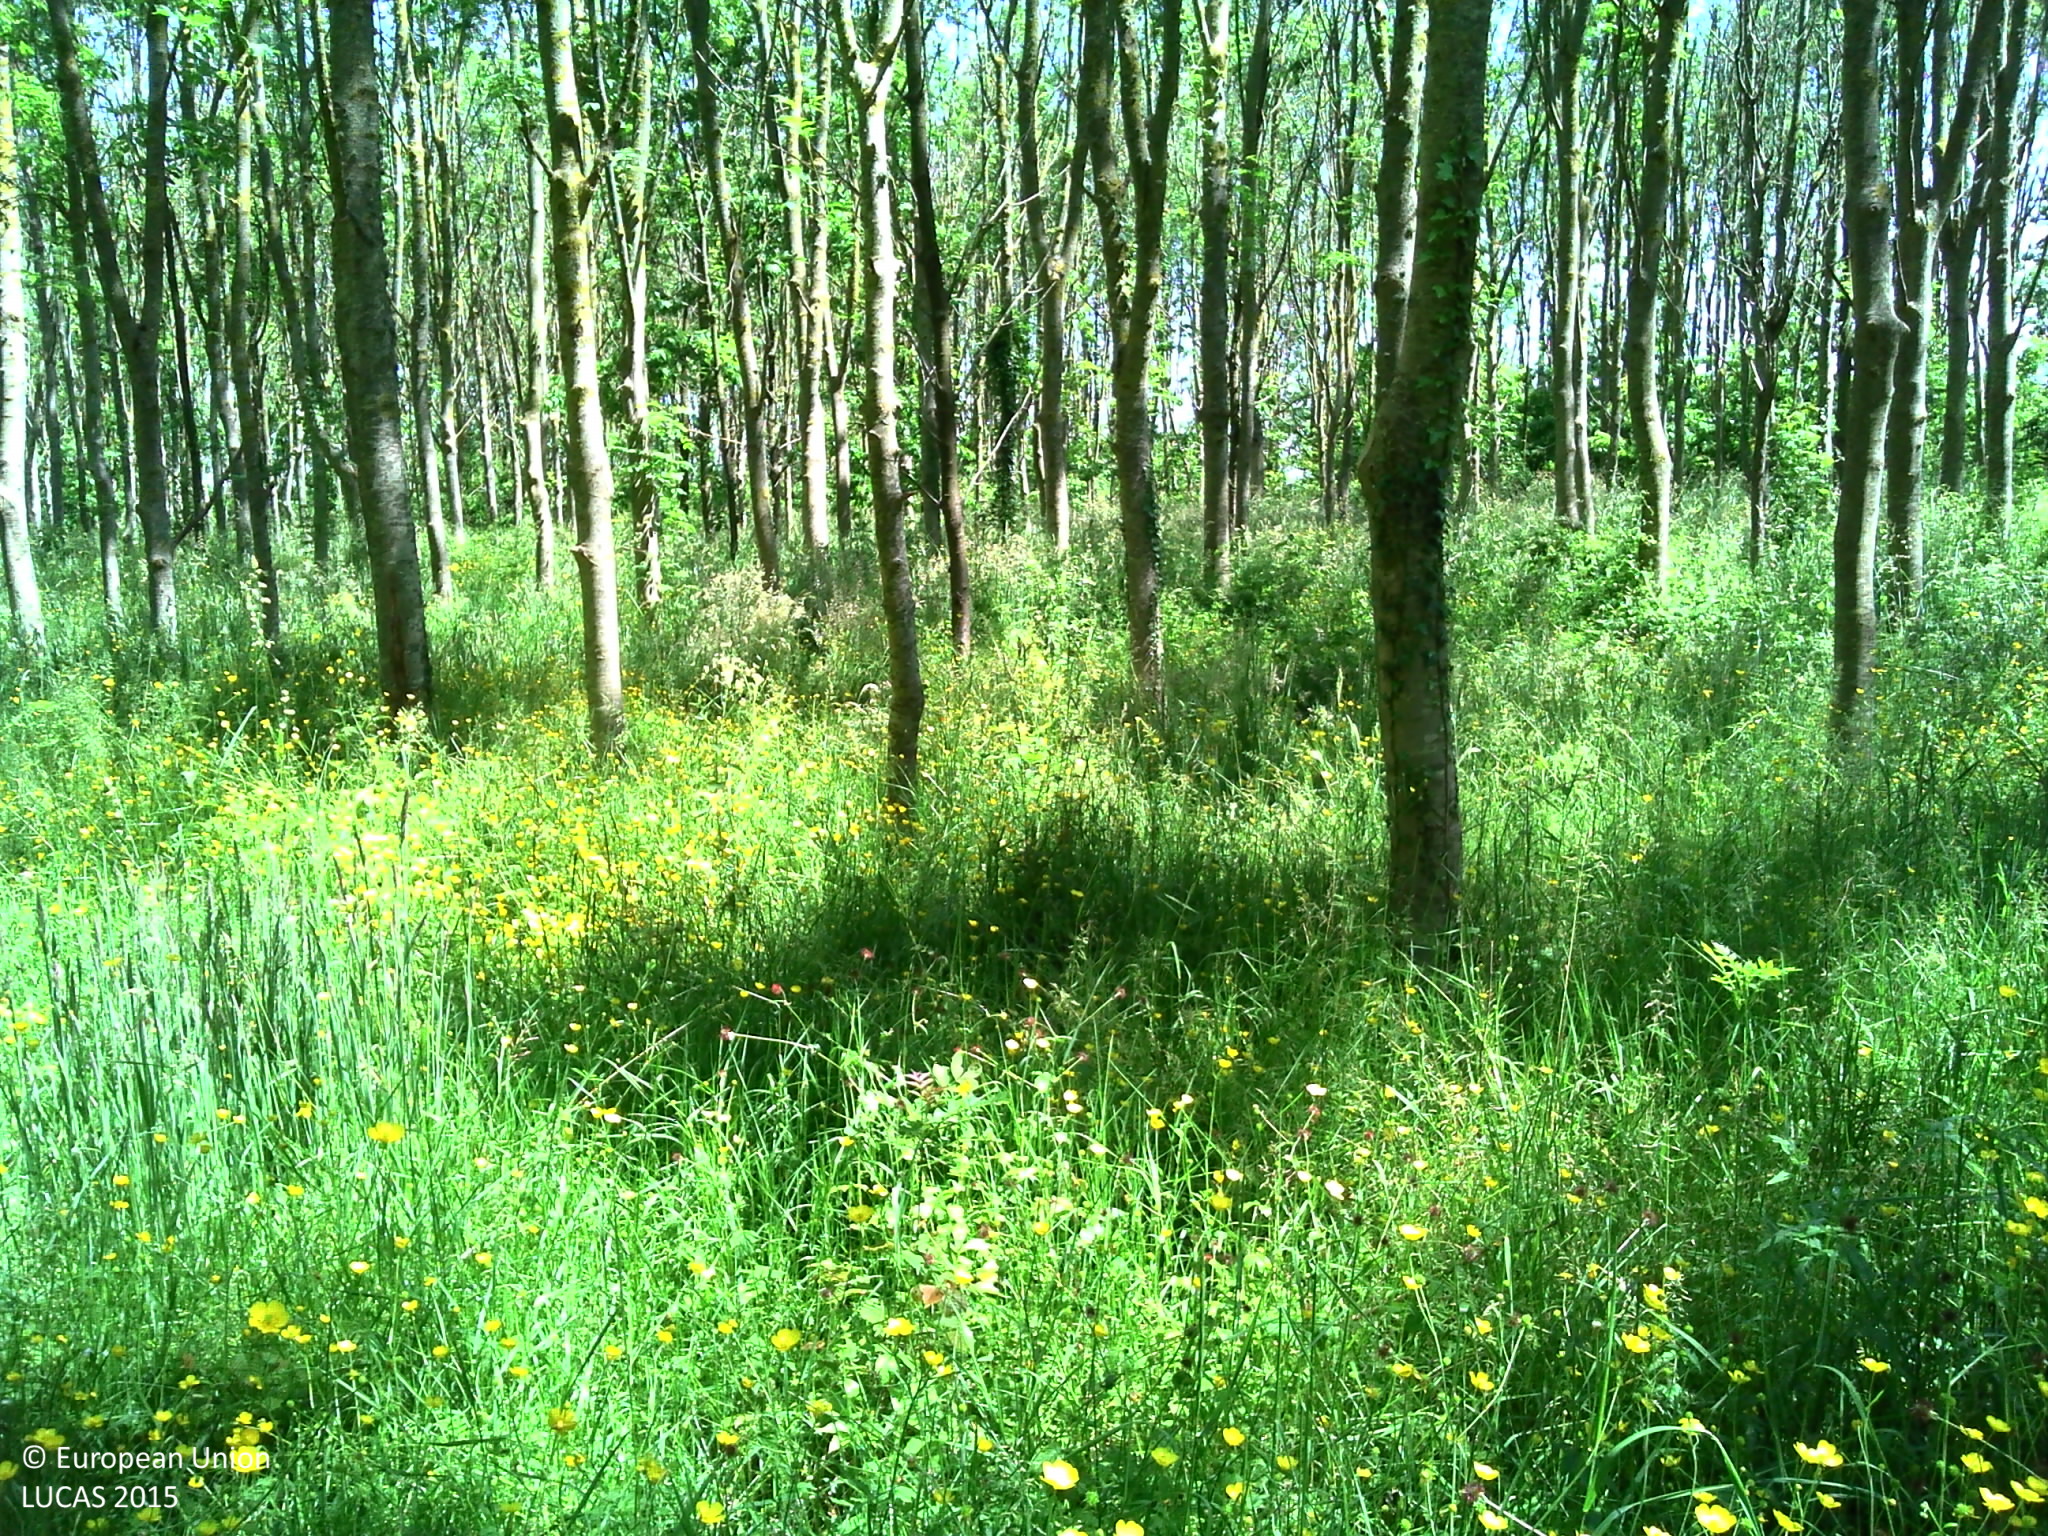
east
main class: Woodland
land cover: Broadleaved woodland
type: mesophytic deciduous forest
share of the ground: 50 - 75 %
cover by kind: broadleaved forest trees 60 %, herbaceous plants 20 %
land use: Forestry
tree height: > 5 m
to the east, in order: Broadleaved woodland; Fences; Temporary grasslands; Grass margins; Paved roads, cycling and walking lanes; Grass margins; Maize; Common wheat
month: June
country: FR
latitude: 50.7762
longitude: 2.0857
